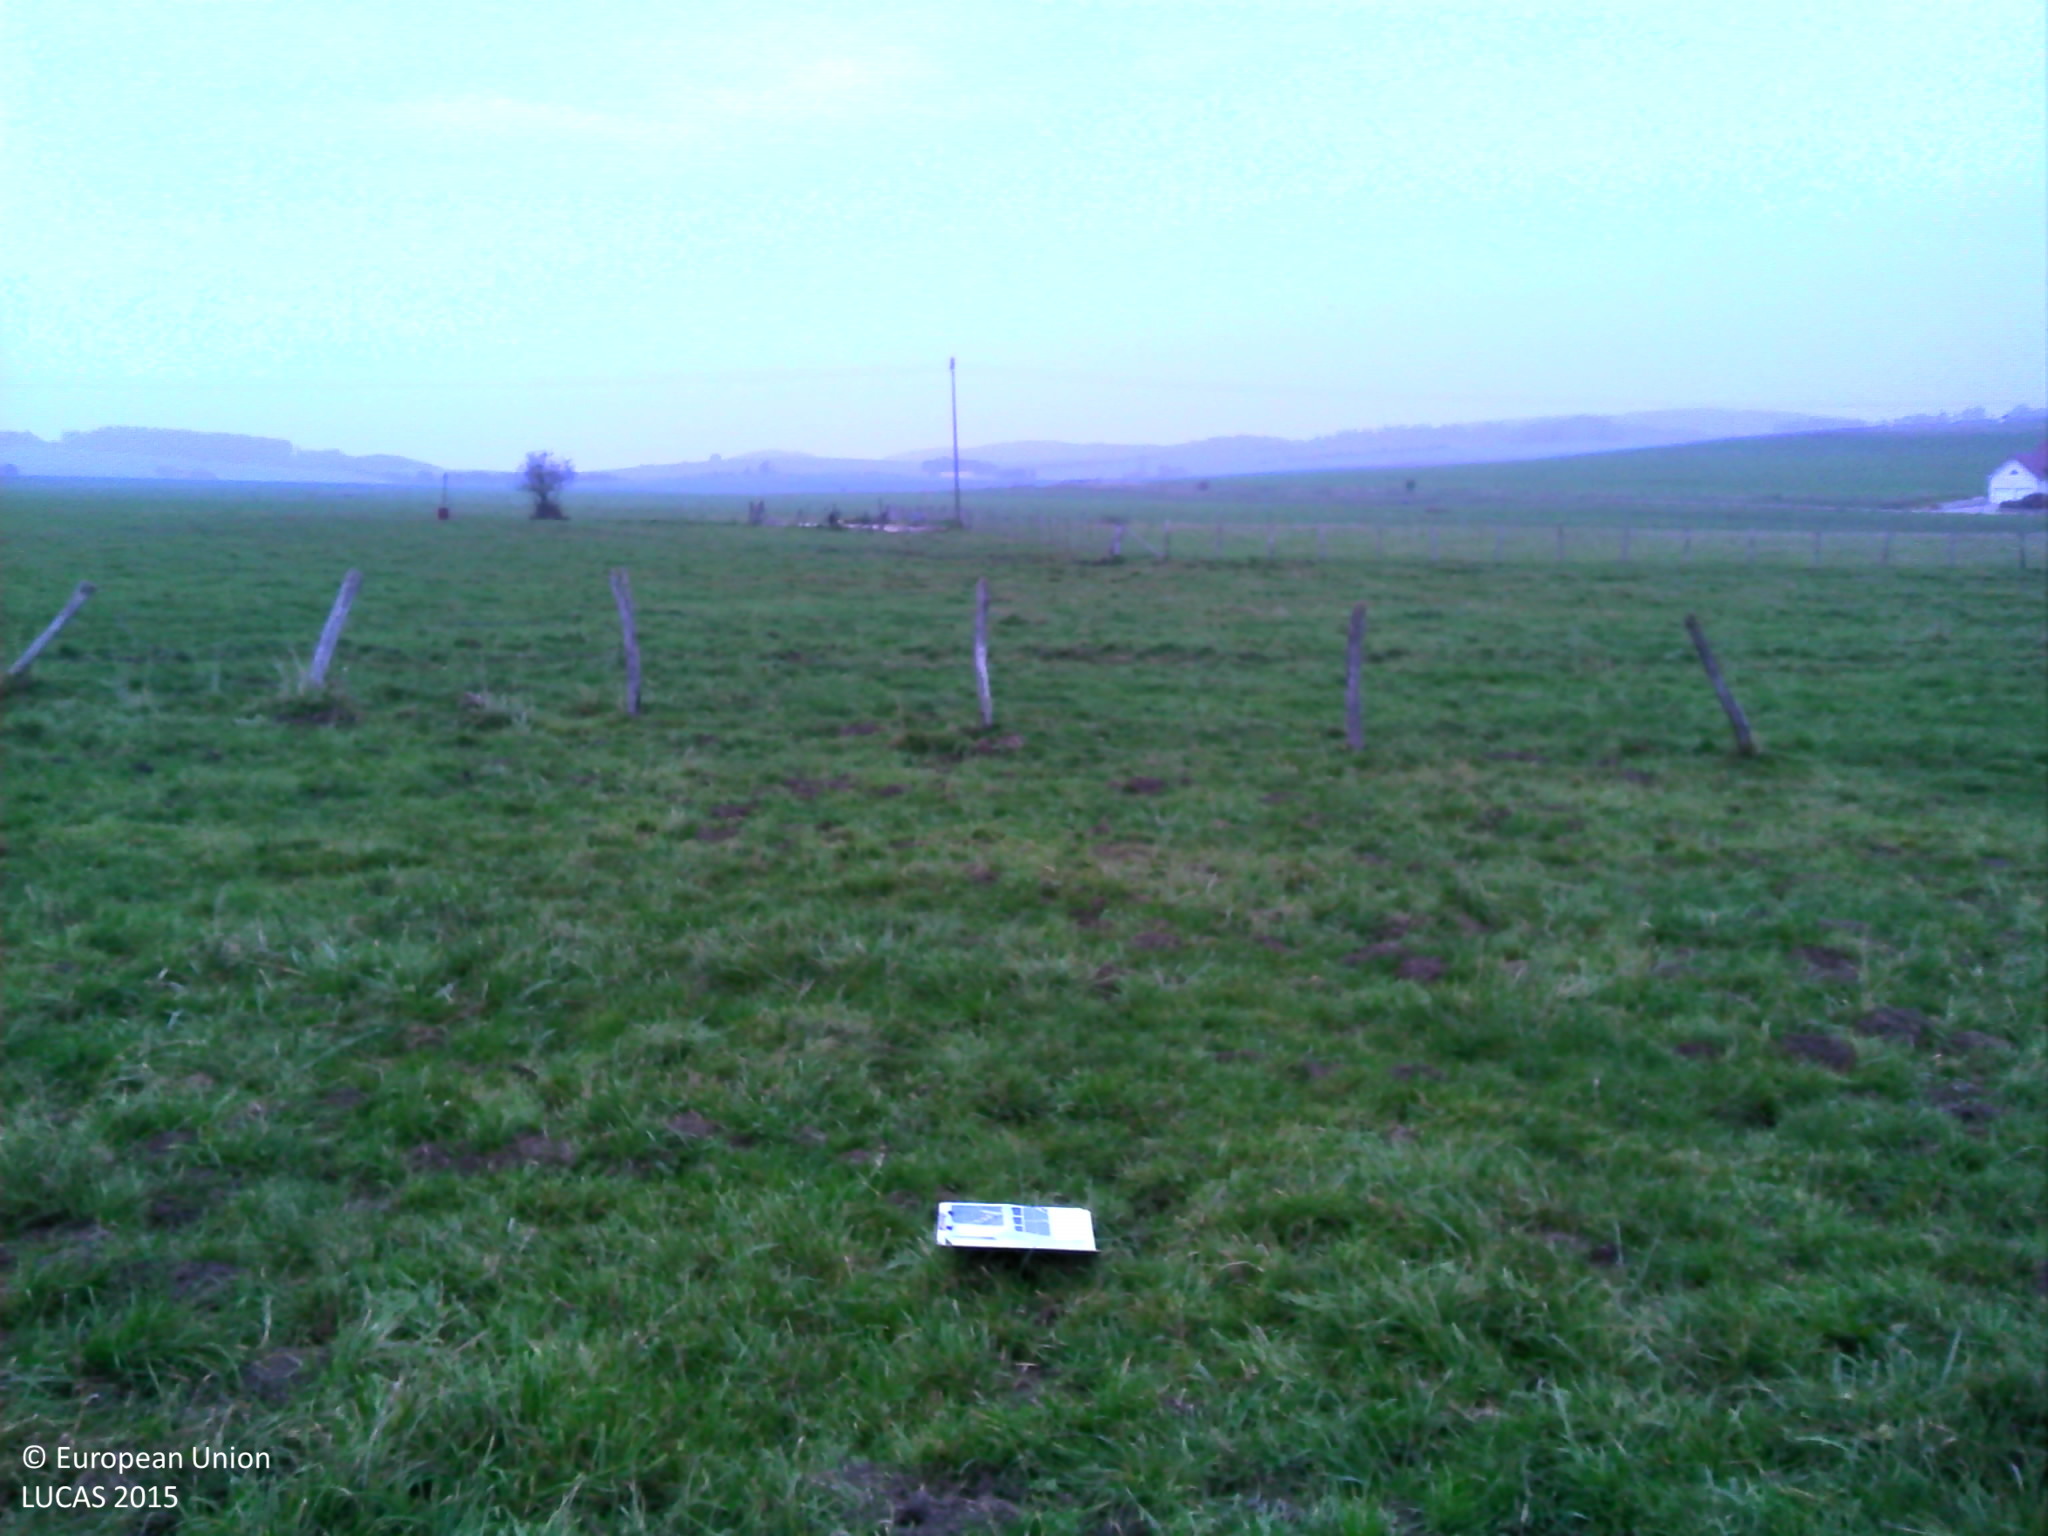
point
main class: Grassland
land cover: Grassland without tree/shrub cover
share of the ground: > 75 %
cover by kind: herbaceous plants 100 %
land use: Agriculture (excluding fallow land and kitchen gardens)
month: October
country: FR
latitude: 46.8923
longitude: 6.0780
